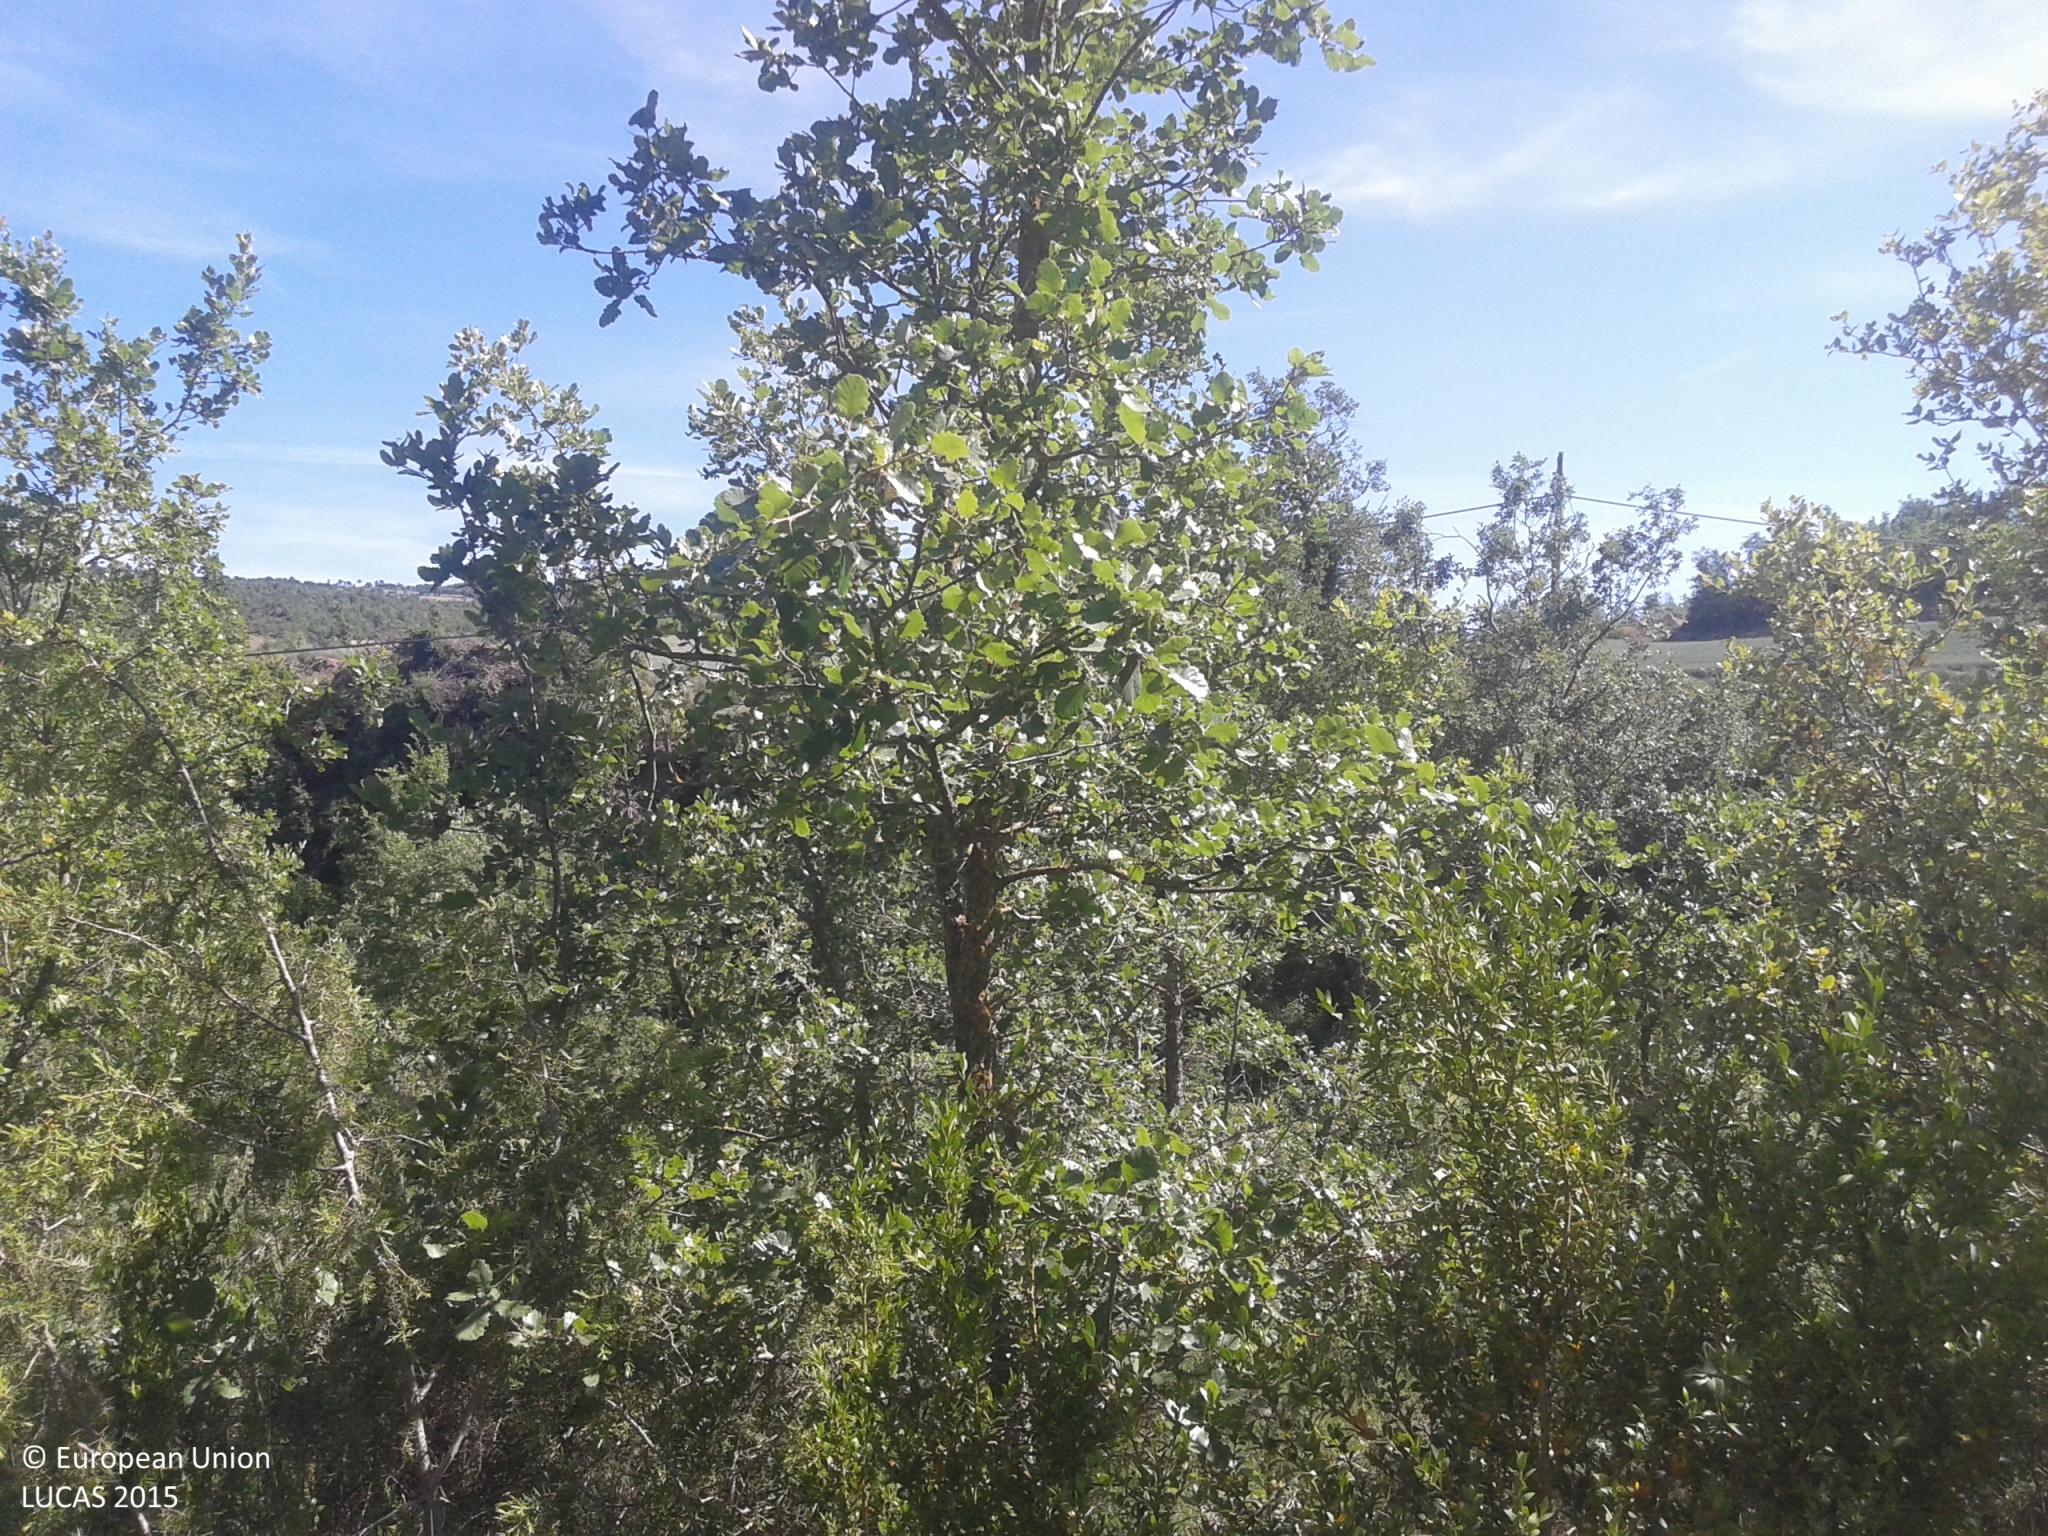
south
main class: Woodland
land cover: Broadleaved woodland
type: thermophilous deciduous forest
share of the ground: 50 - 75 %
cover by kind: broadleaved forest trees 65 %, shrubs 30 %, herbaceous plants 5 %
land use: Semi-natural and natural areas not in use
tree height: < 5 m
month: May
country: ES
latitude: 41.8324
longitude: 1.5970
